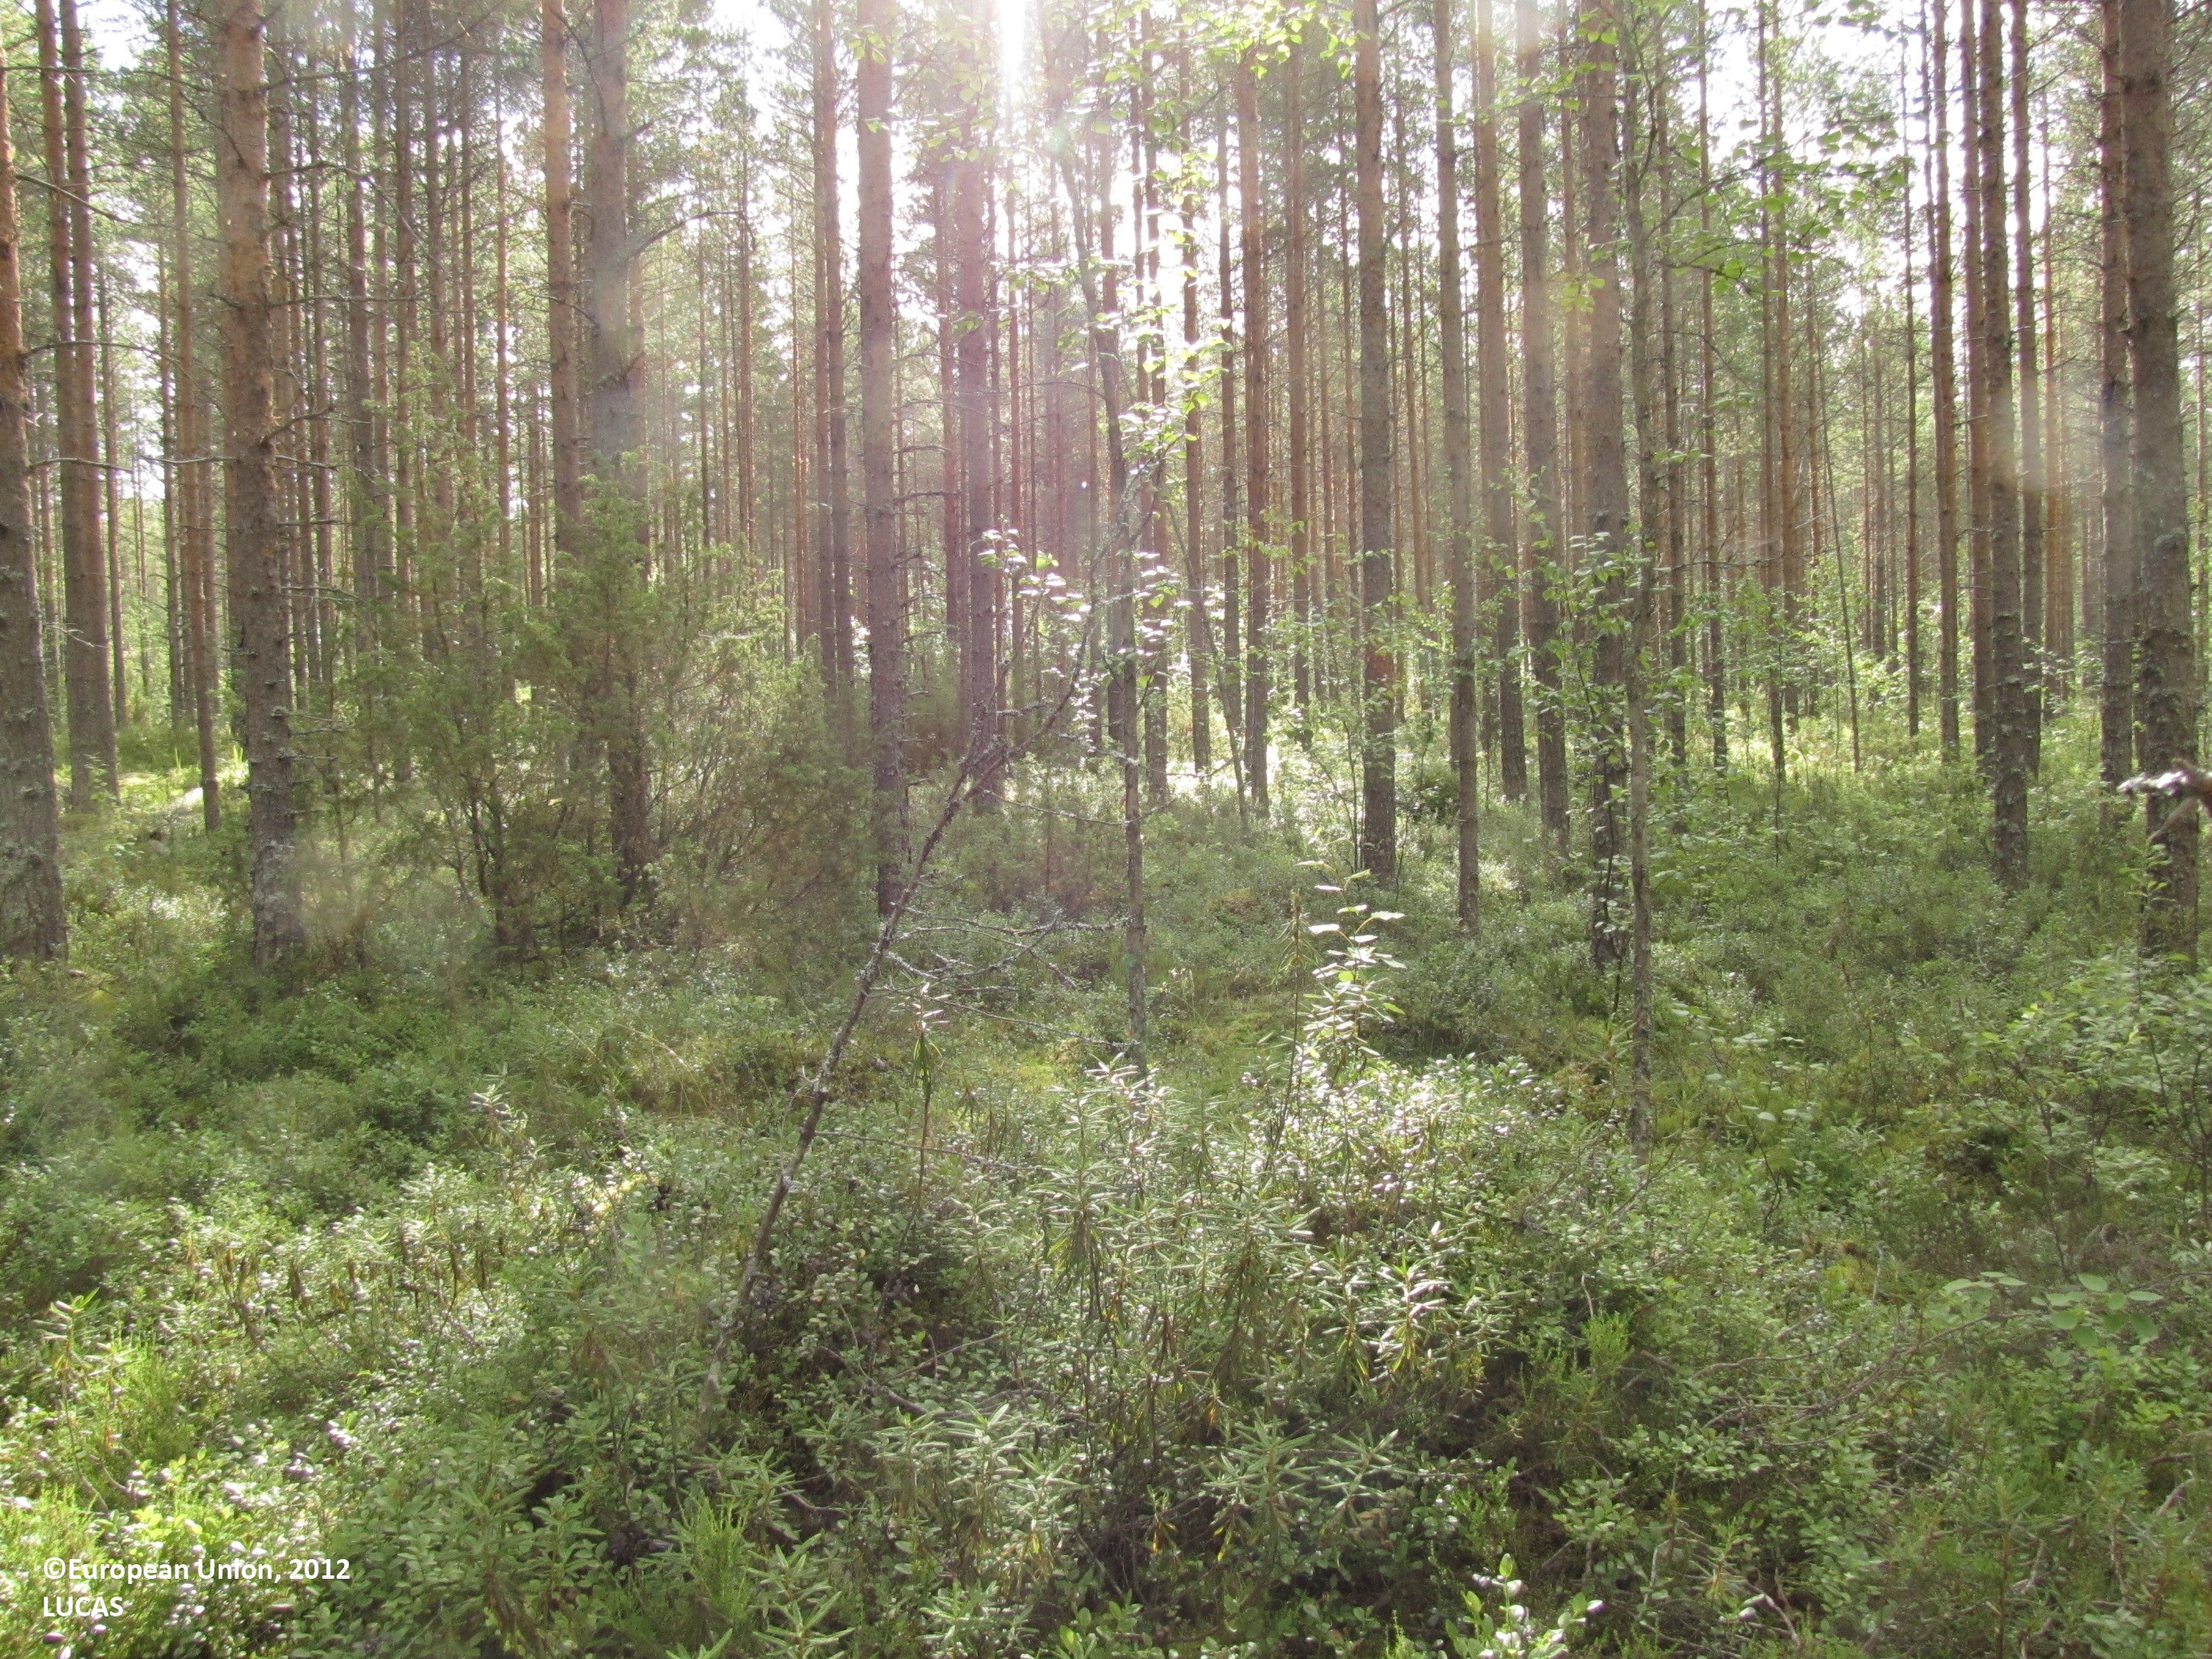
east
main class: Woodland
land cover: Pine dominated coniferous woodland
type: mire and swamp forests
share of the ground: > 75 %
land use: Forestry
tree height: > 5 m
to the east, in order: Pine dominated coniferous woodland
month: July
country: FI
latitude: 62.4338
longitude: 23.3766
